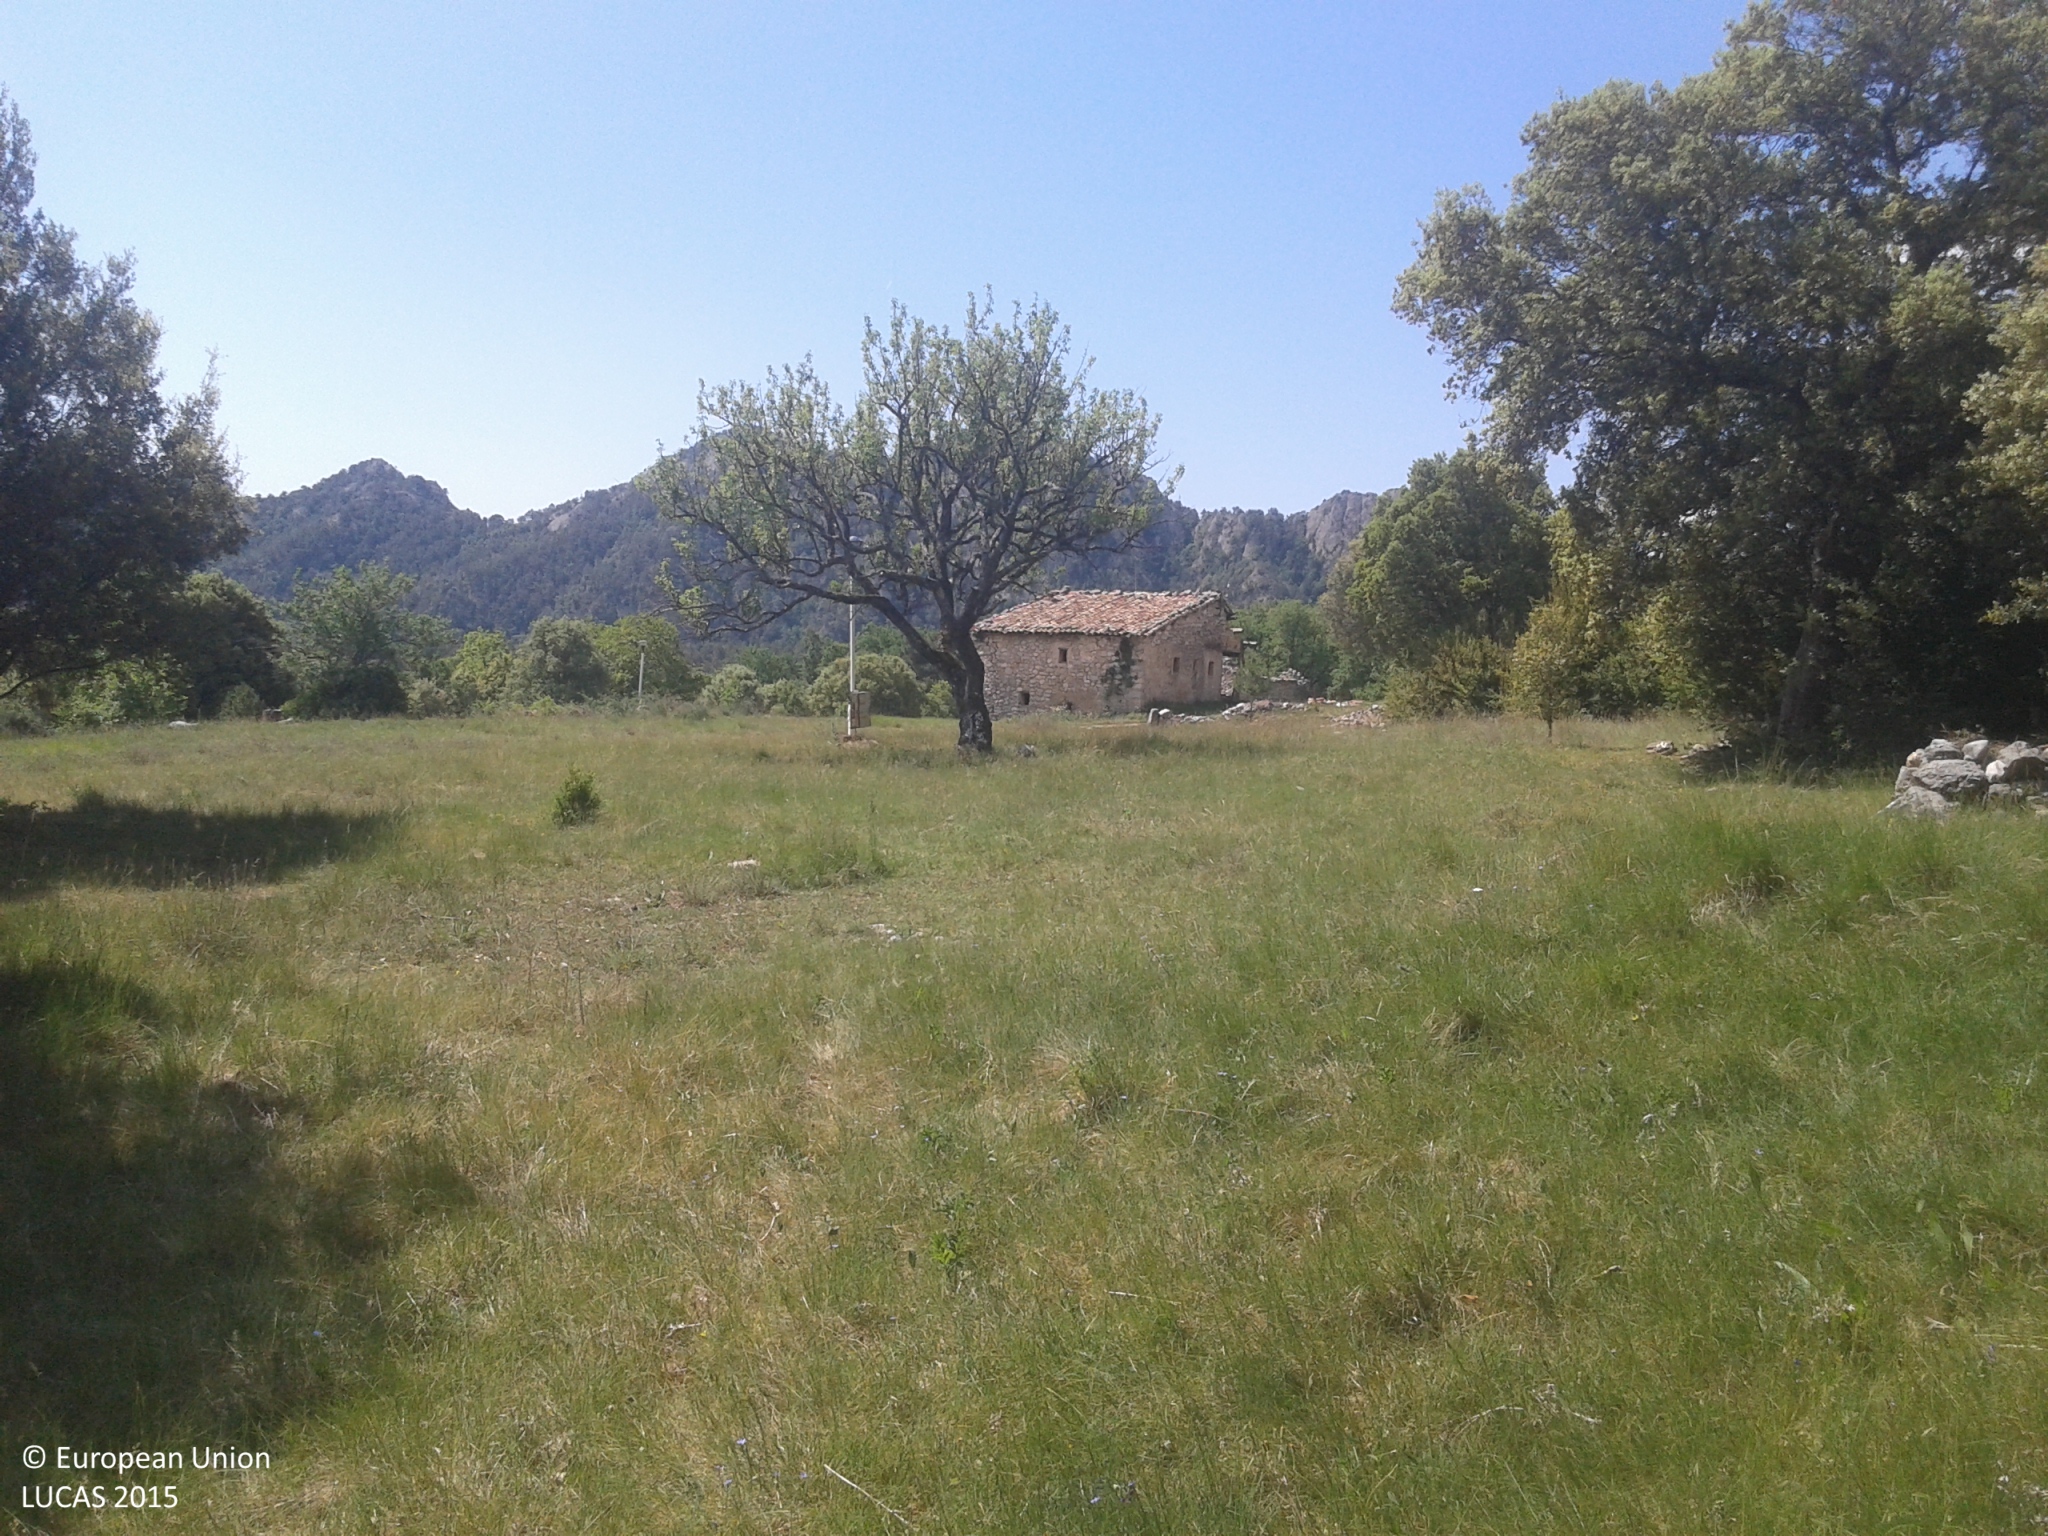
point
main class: Grassland
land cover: Grassland with sparse tree/shrub cover
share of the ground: > 75 %
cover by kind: herbaceous plants 95 %, broadleaved forest trees 5 %
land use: Agriculture (excluding fallow land and kitchen gardens)
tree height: > 5 m
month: May
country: ES
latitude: 42.1395
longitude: 1.5786
